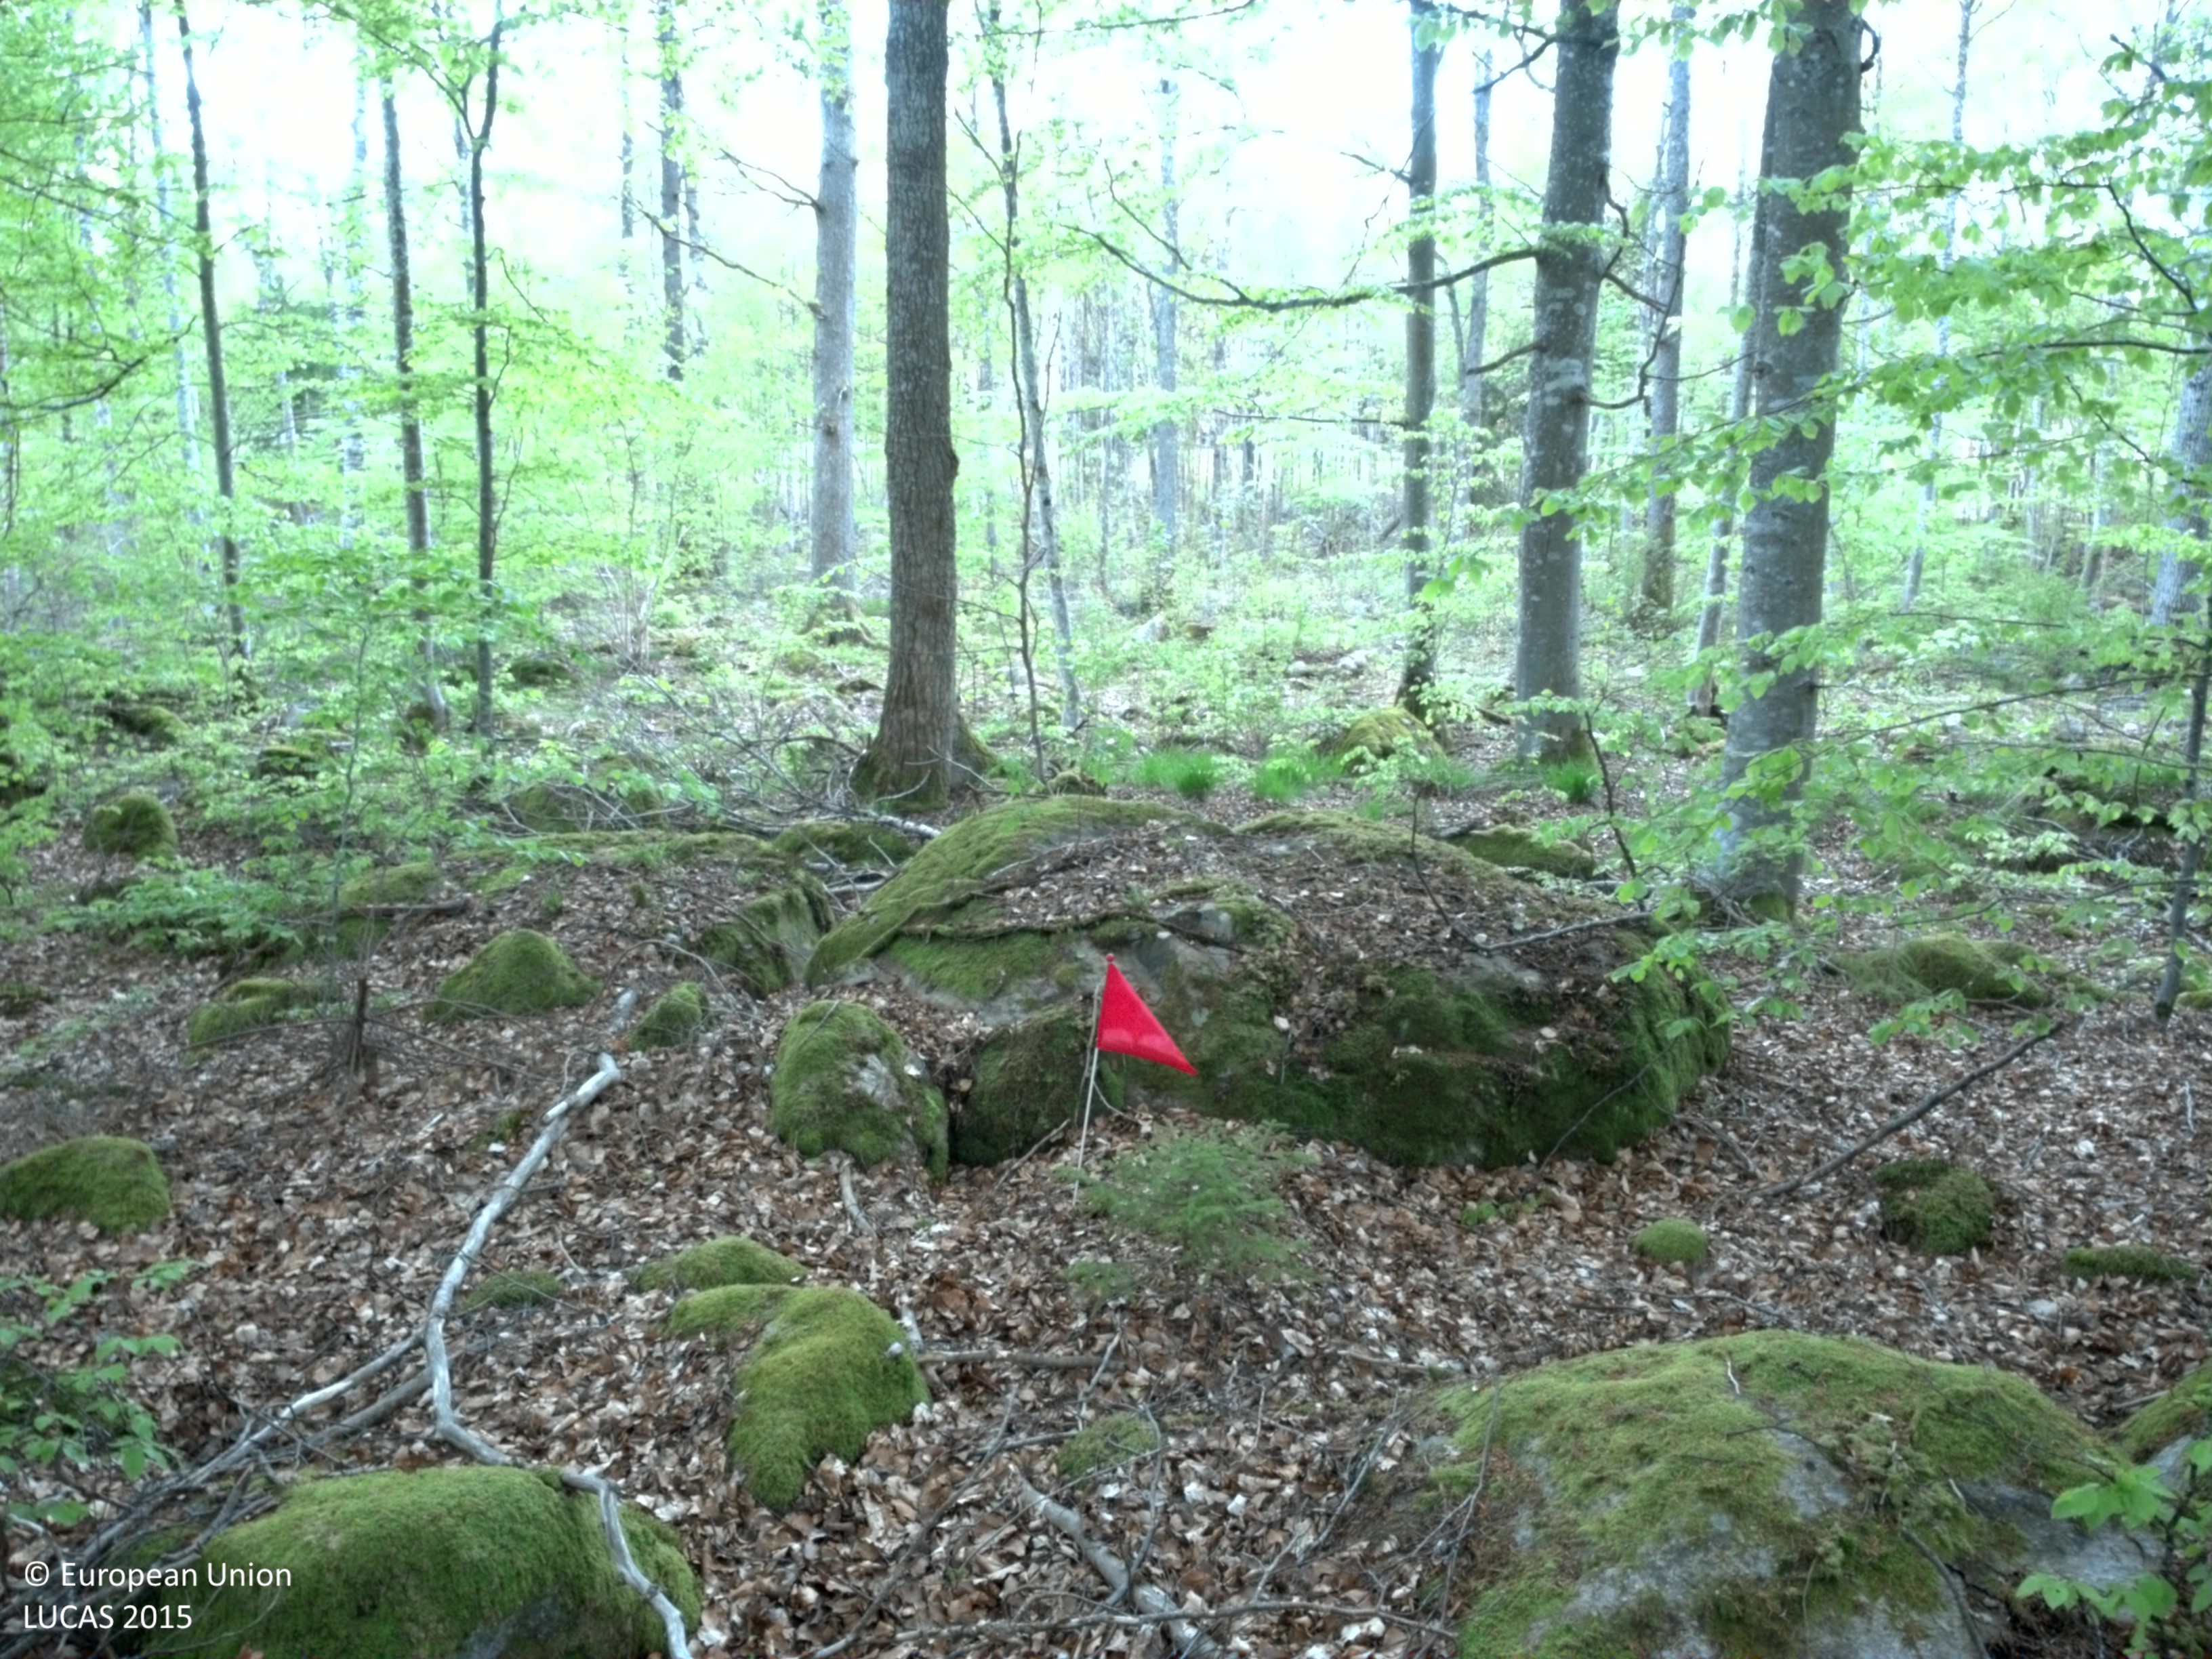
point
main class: Woodland
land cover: Broadleaved woodland
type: beech forest
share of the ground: > 75 %
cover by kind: broadleaved forest trees 80 %, herbaceous plants 10 %, lichens and mosses 10 %
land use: Amenities, museums, leisure
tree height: > 5 m
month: May
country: SE
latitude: 56.6487
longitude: 14.5149
